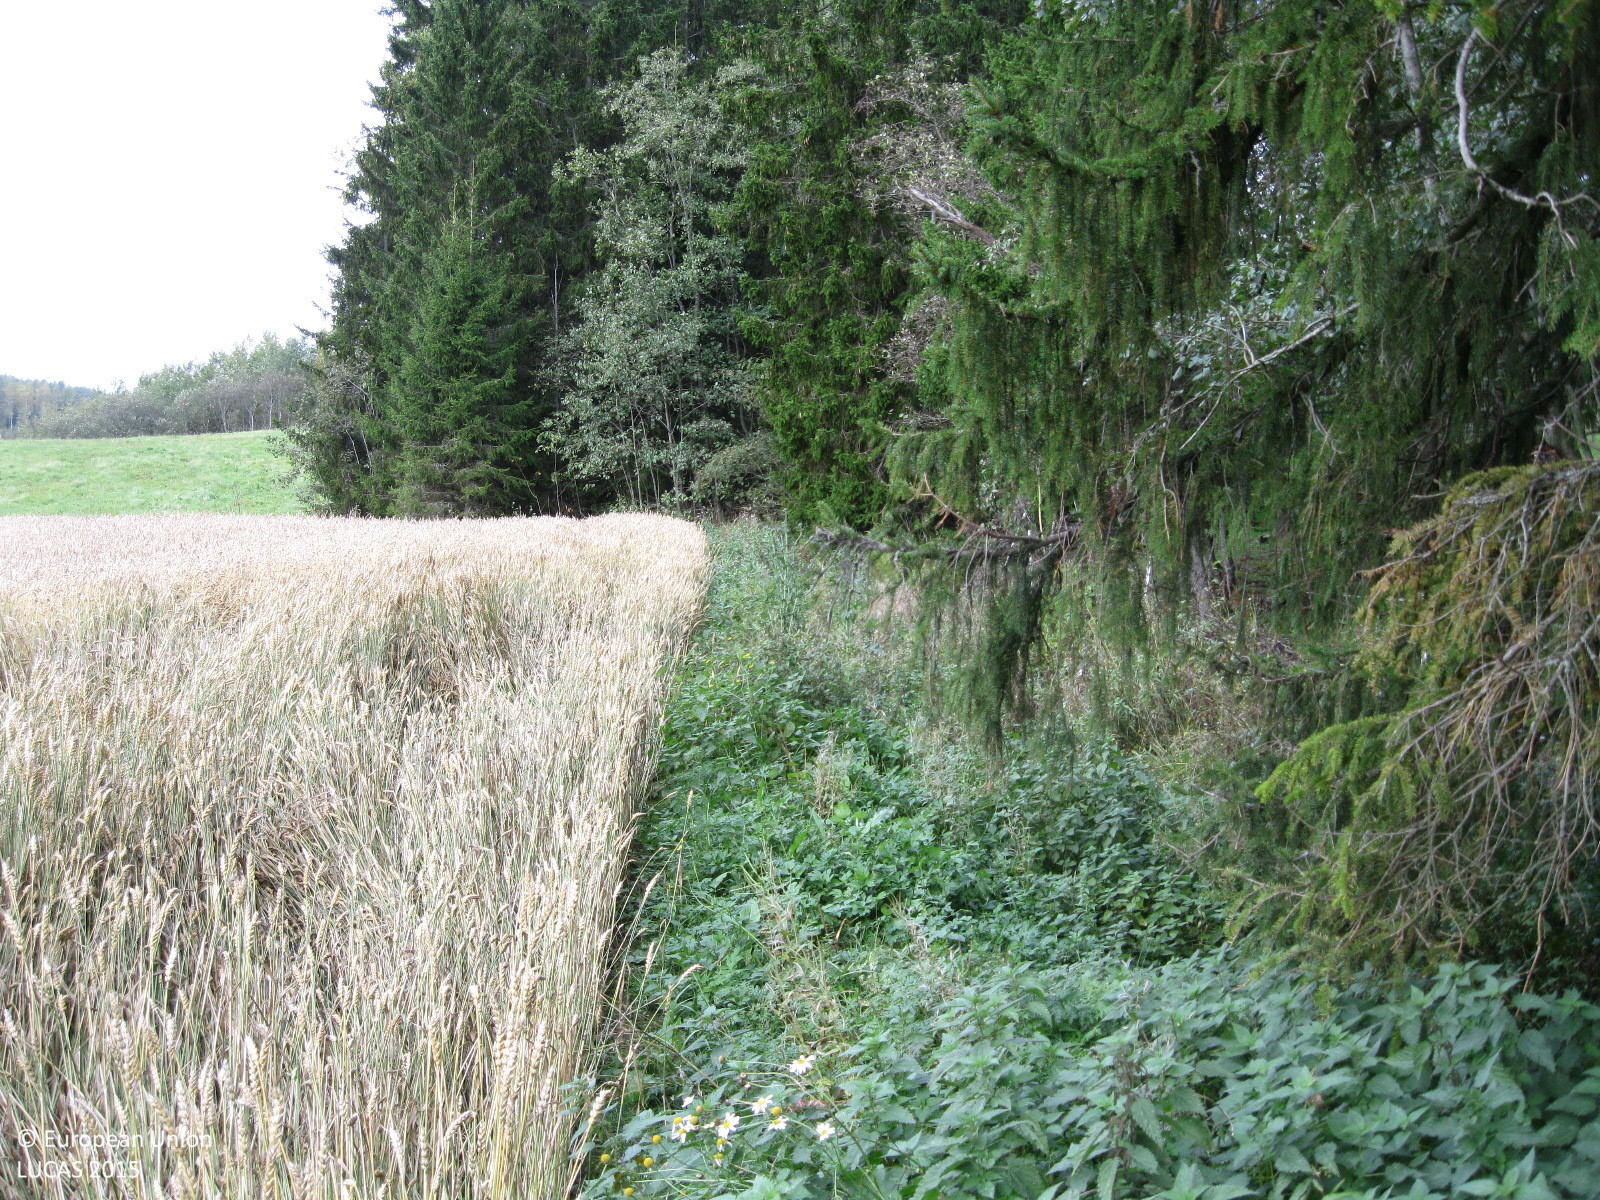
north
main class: Cropland
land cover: Common wheat
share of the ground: > 75 %
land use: Agriculture (excluding fallow land and kitchen gardens)
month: September
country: FI
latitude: 60.4171
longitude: 24.1364
